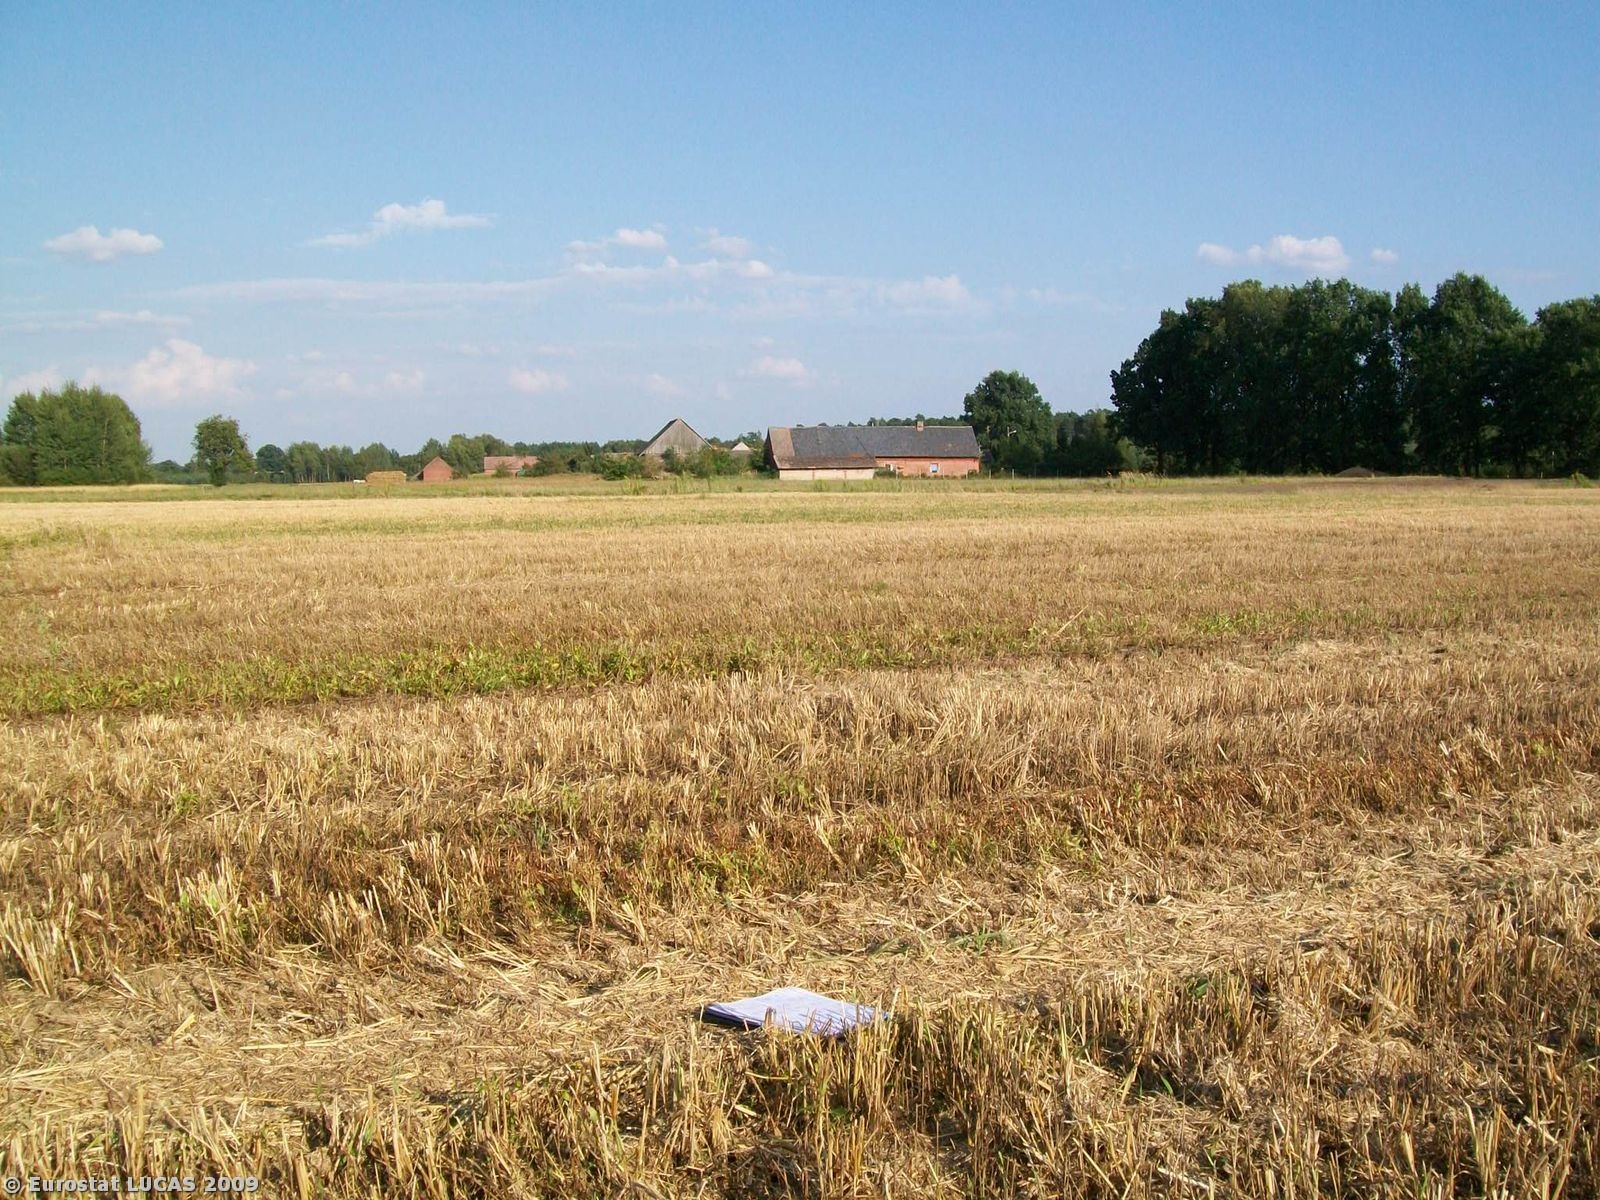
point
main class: Cropland
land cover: Barley
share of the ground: < 10 %
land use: Agriculture (excluding fallow land and kitchen gardens)
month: August
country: PL
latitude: 50.9745
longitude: 17.9196
